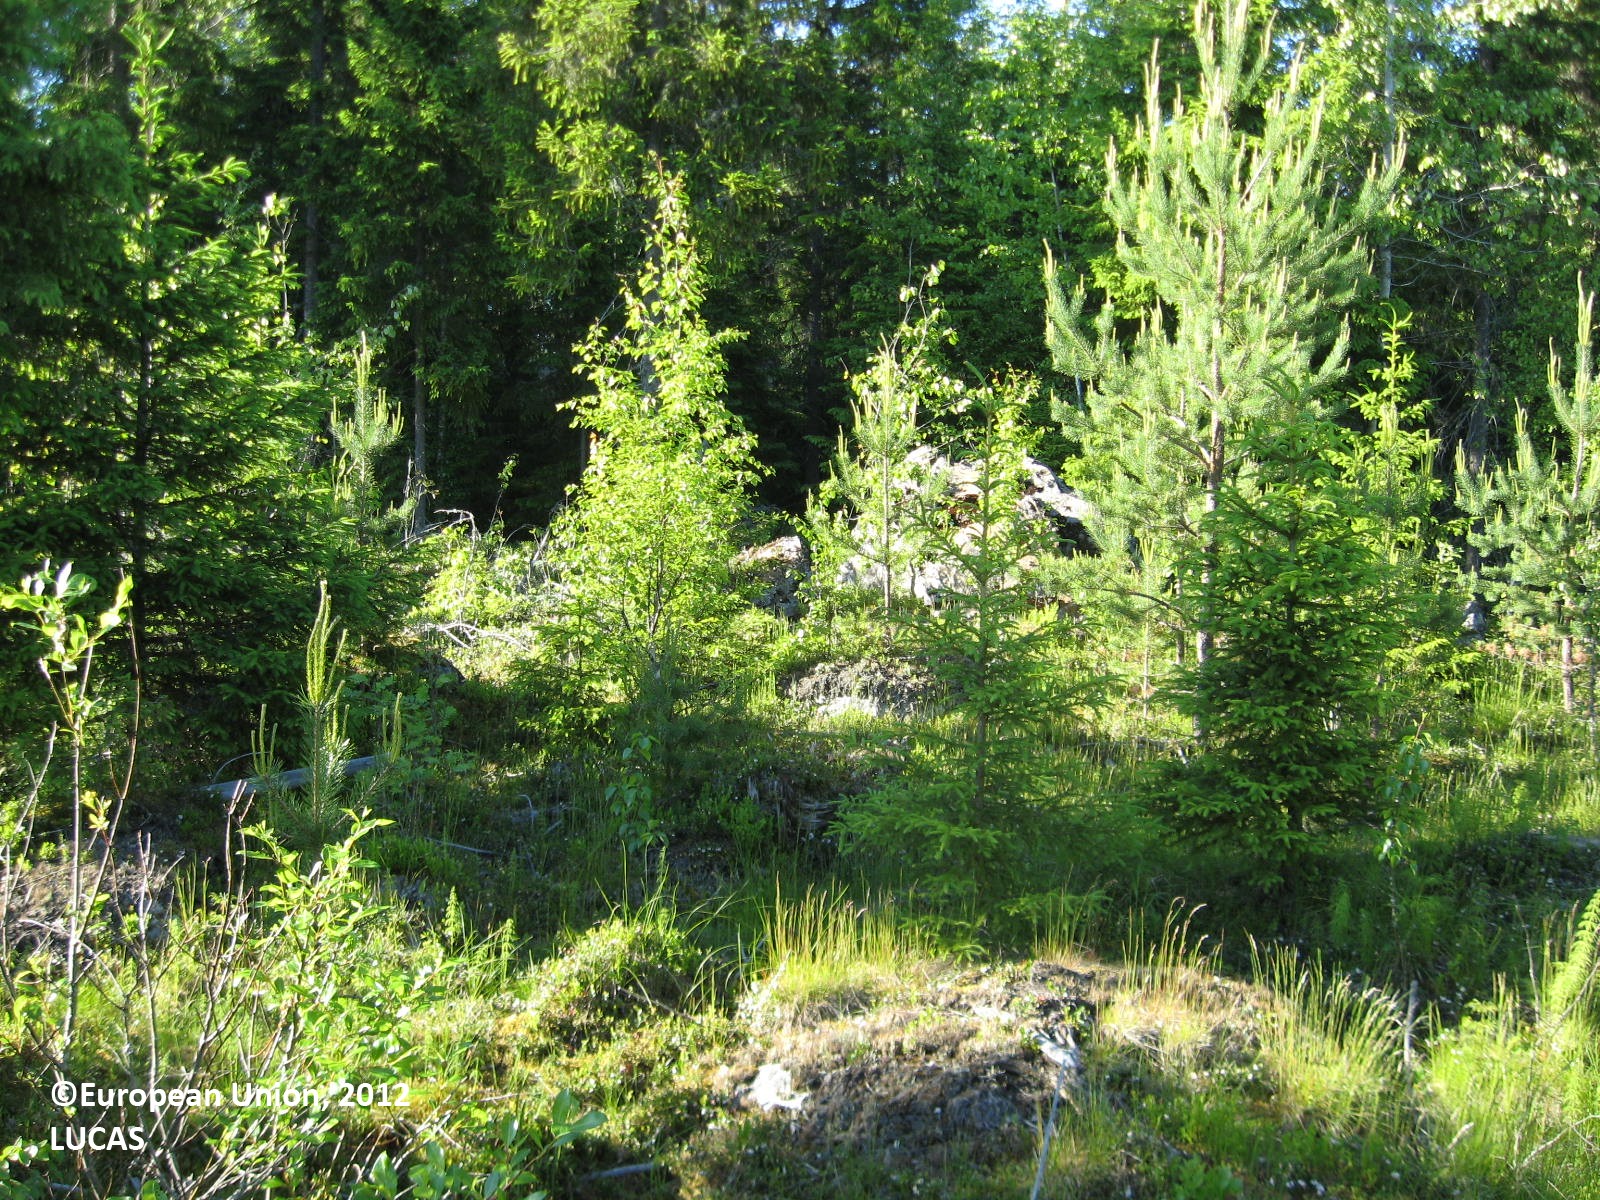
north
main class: Woodland
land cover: Broadleaved woodland
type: boreal forest
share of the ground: > 75 %
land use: Forestry
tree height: > 5 m
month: June
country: FI
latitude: 62.9438
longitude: 21.8875
